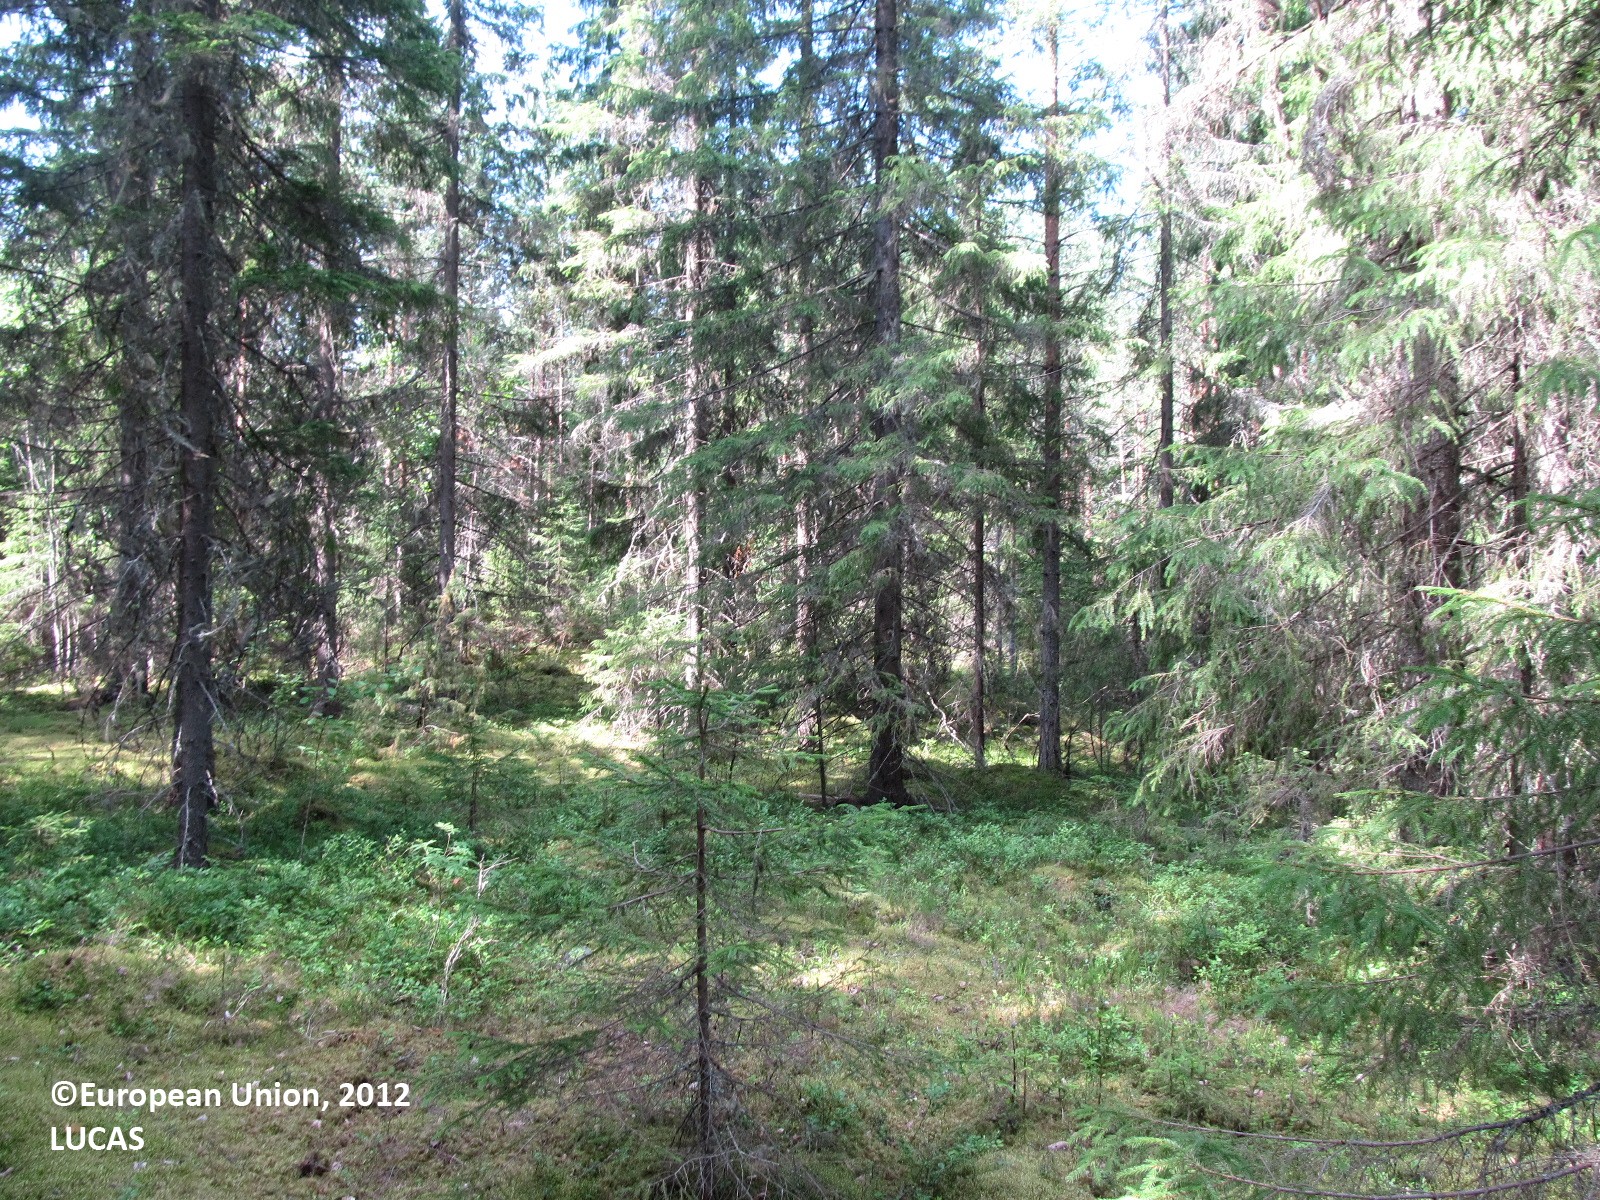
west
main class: Woodland
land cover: Spruce dominated coniferous woodland
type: boreal forest
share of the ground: 25 - 50 %
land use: Forestry
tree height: > 5 m
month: July
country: FI
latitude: 62.0023
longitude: 29.1150
